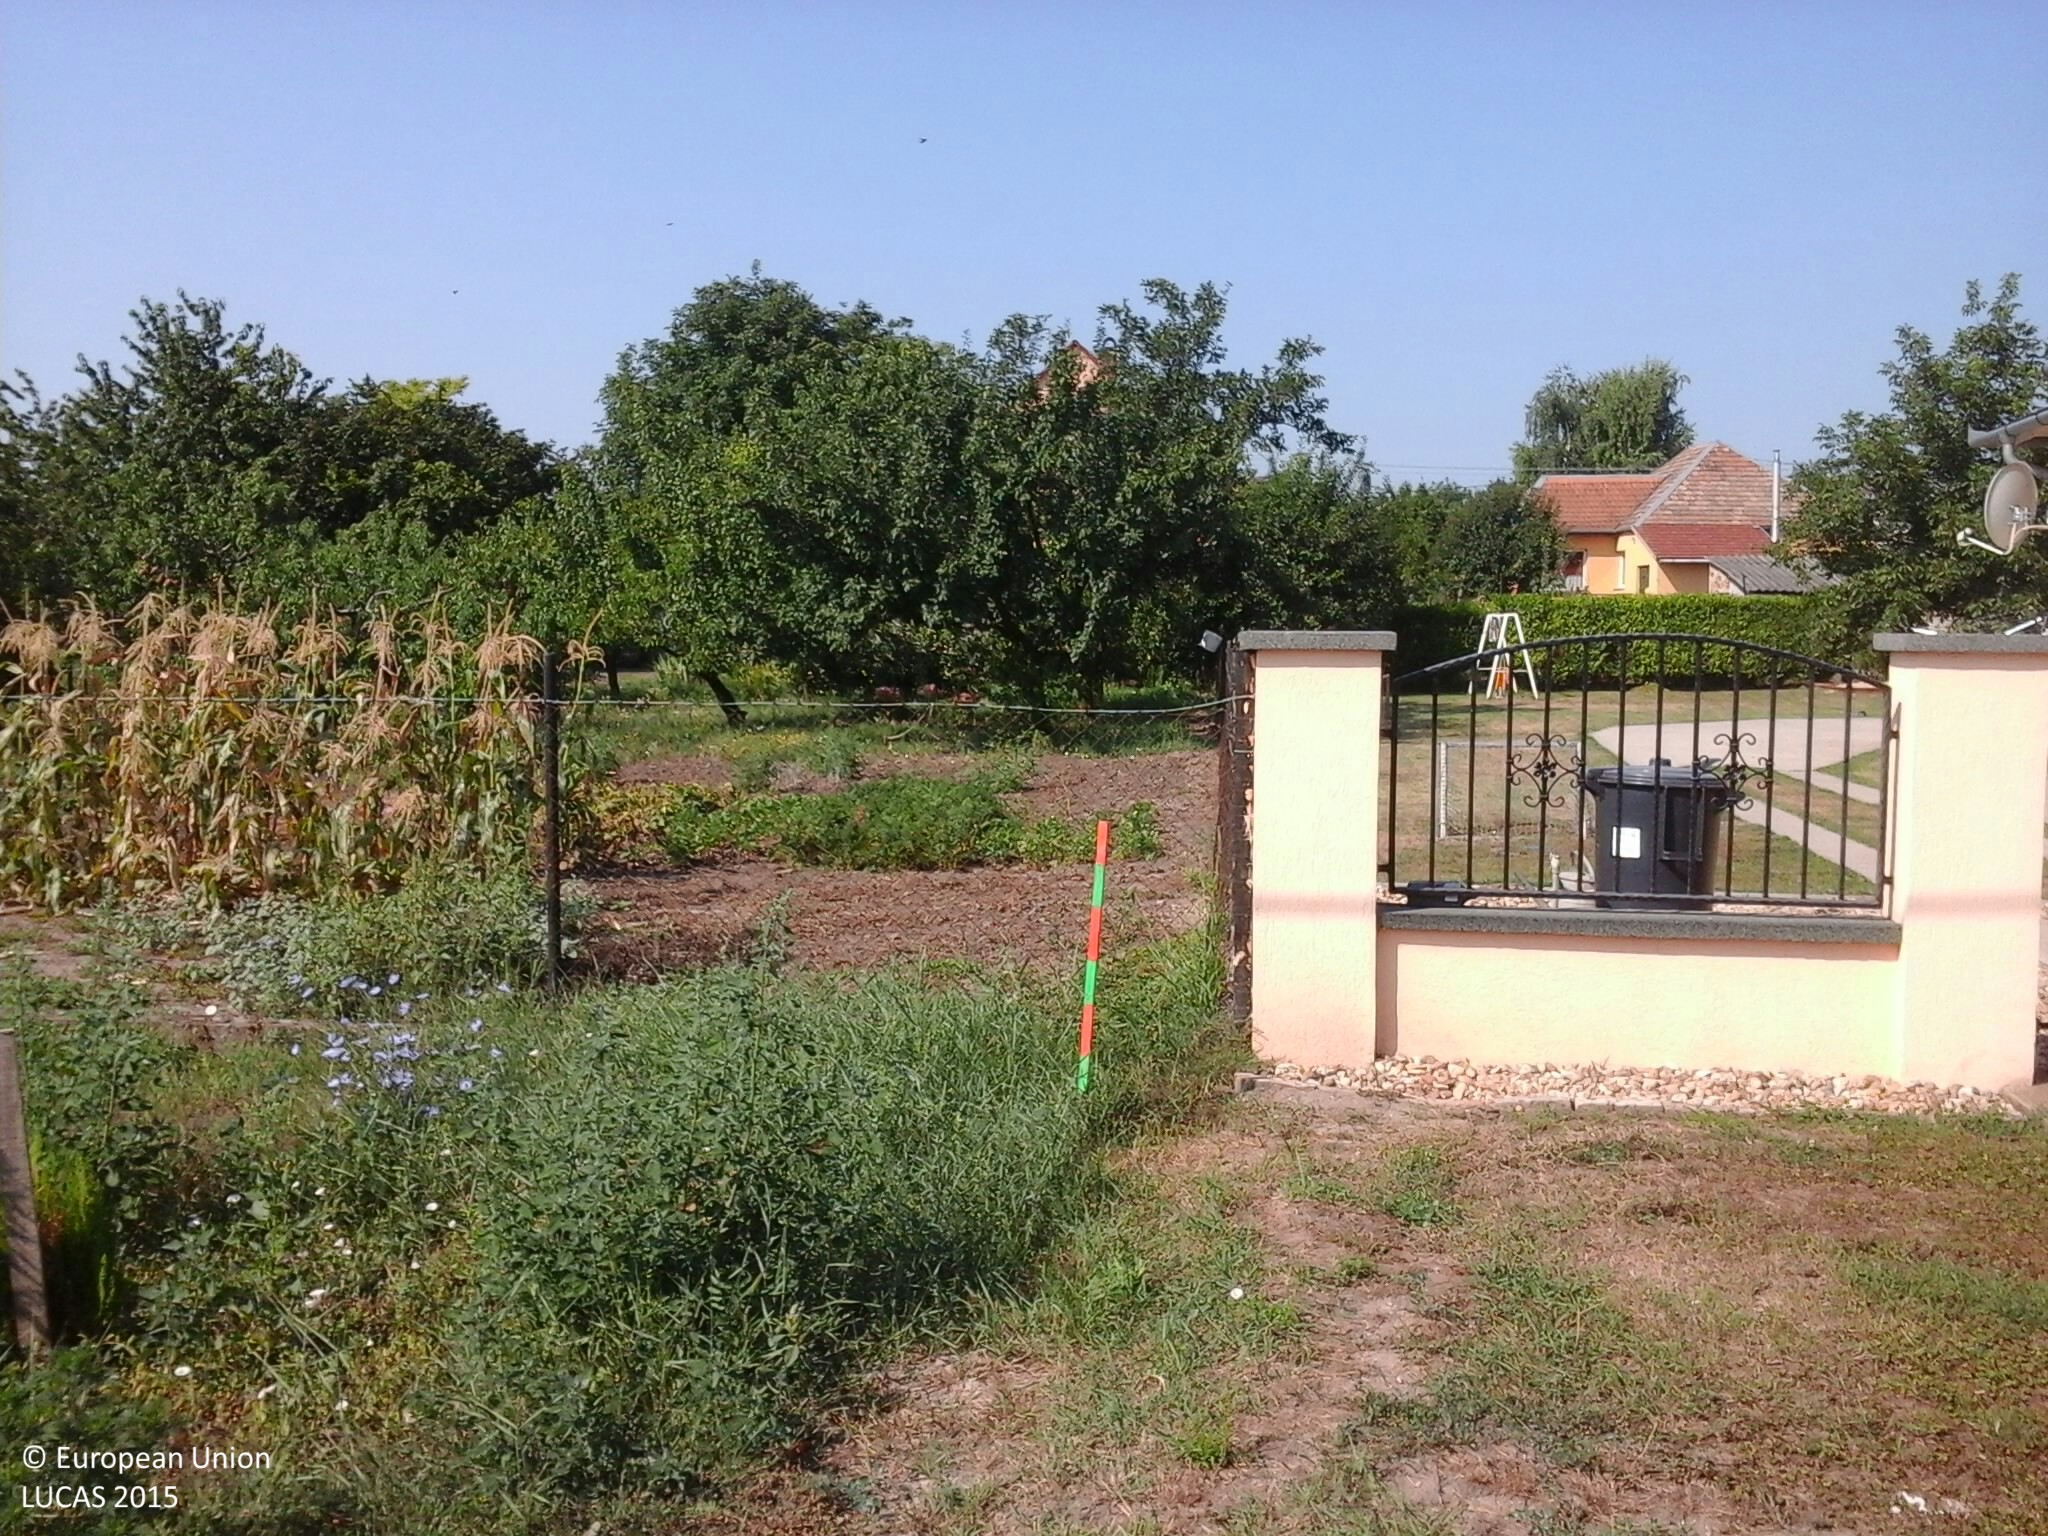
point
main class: Grassland
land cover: Grassland without tree/shrub cover
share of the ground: > 75 %
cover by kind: herbaceous plants 100 %
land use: Residential
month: August
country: HU
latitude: 46.9572
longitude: 18.2232
